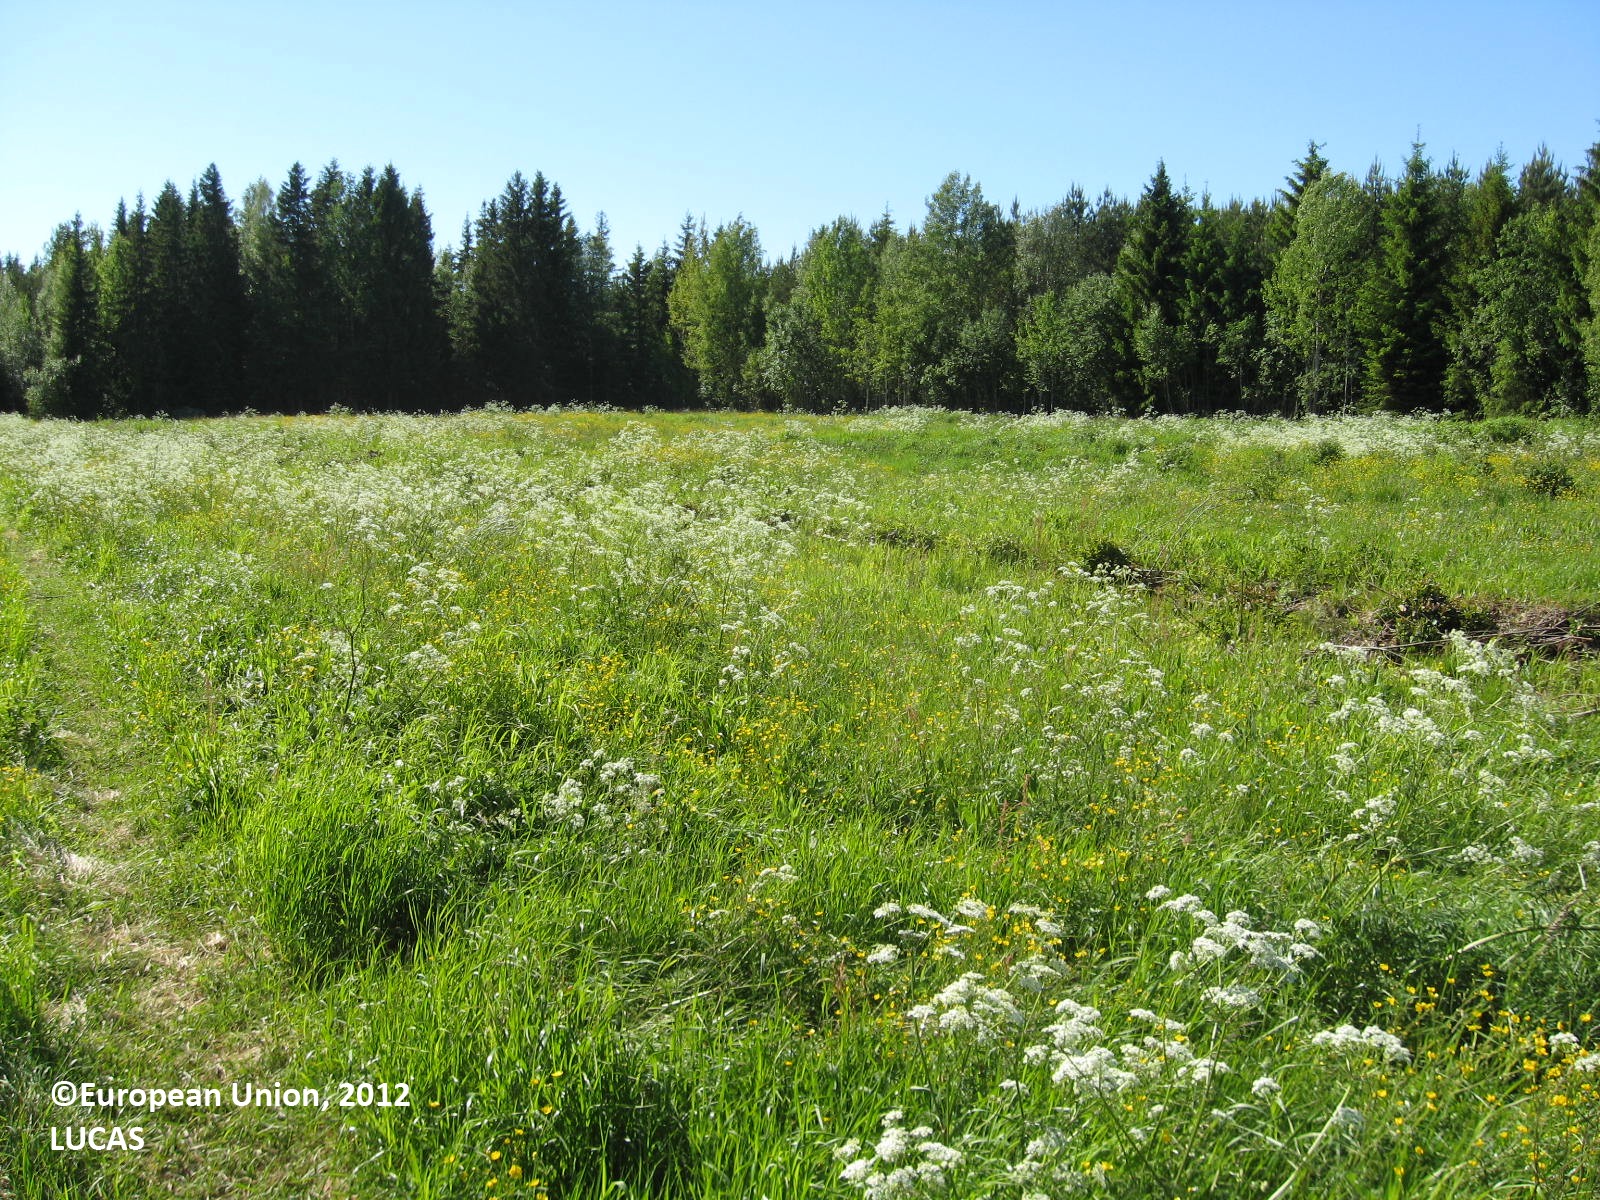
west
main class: Grassland
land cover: Spontaneously vegetated surfaces
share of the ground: > 75 %
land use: Fallow land
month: June
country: FI
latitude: 62.7368
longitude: 21.2513
